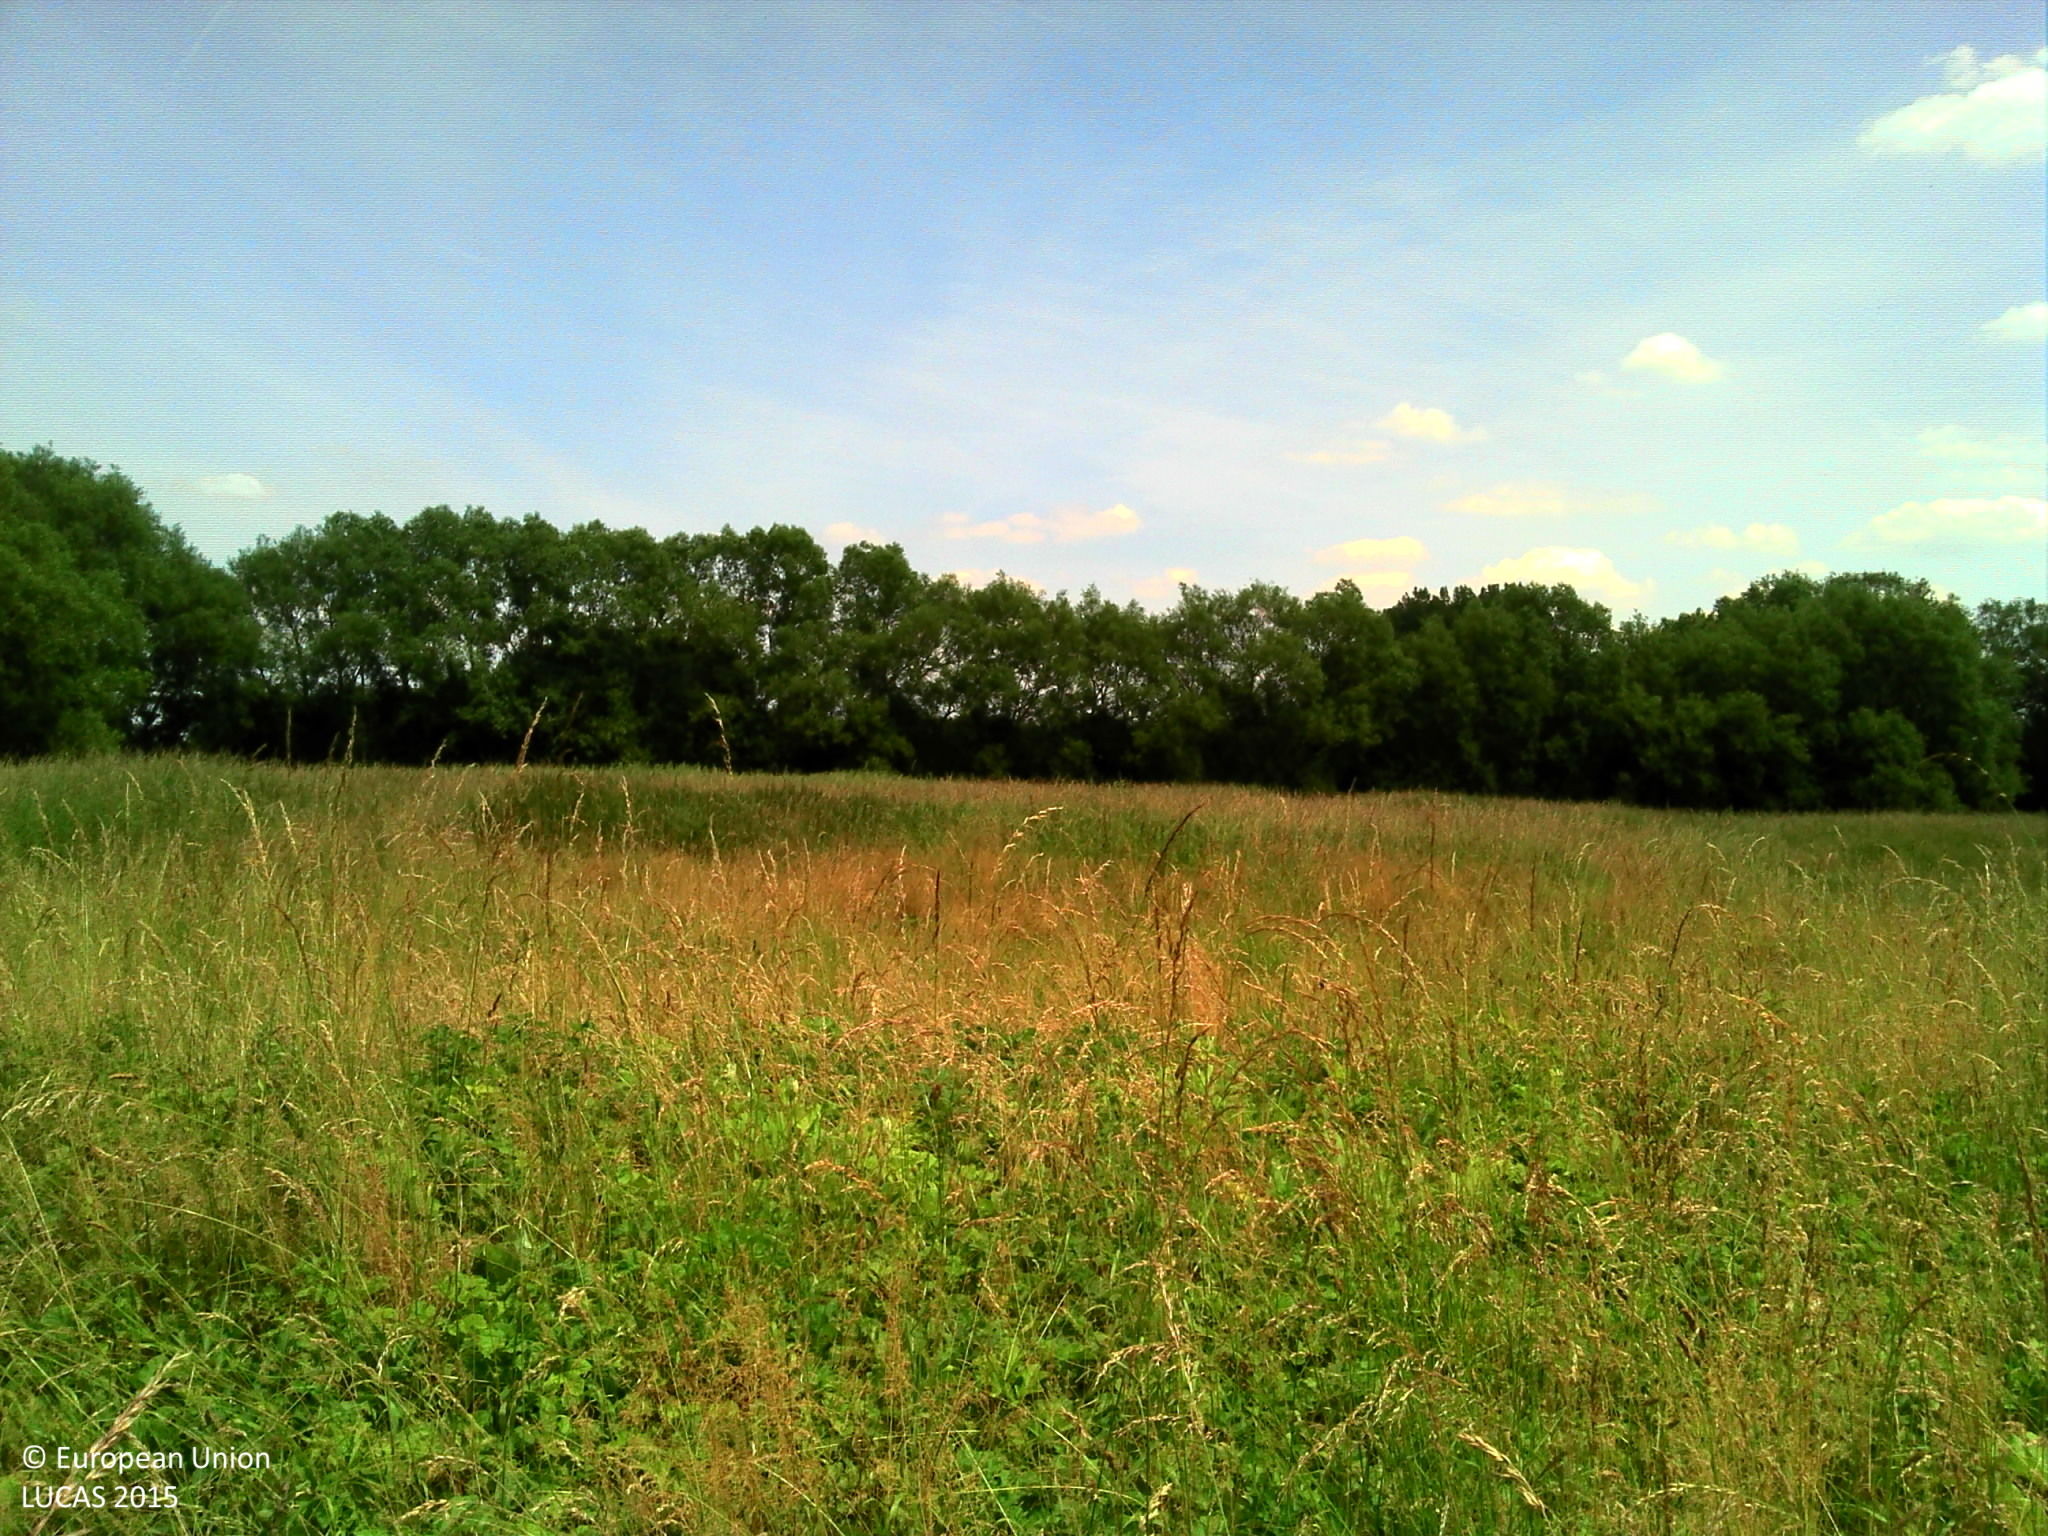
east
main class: Grassland
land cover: Grassland without tree/shrub cover
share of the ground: > 75 %
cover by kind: herbaceous plants 95 %, shrubs 5 %
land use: Agriculture (excluding fallow land and kitchen gardens)
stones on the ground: < 10 %
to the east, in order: Grassland without tree/shrub cover; Lines of trees; Fences; Spontaneously vegetated surfaces; Maize
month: June
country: FR
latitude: 49.3456
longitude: 2.5694
